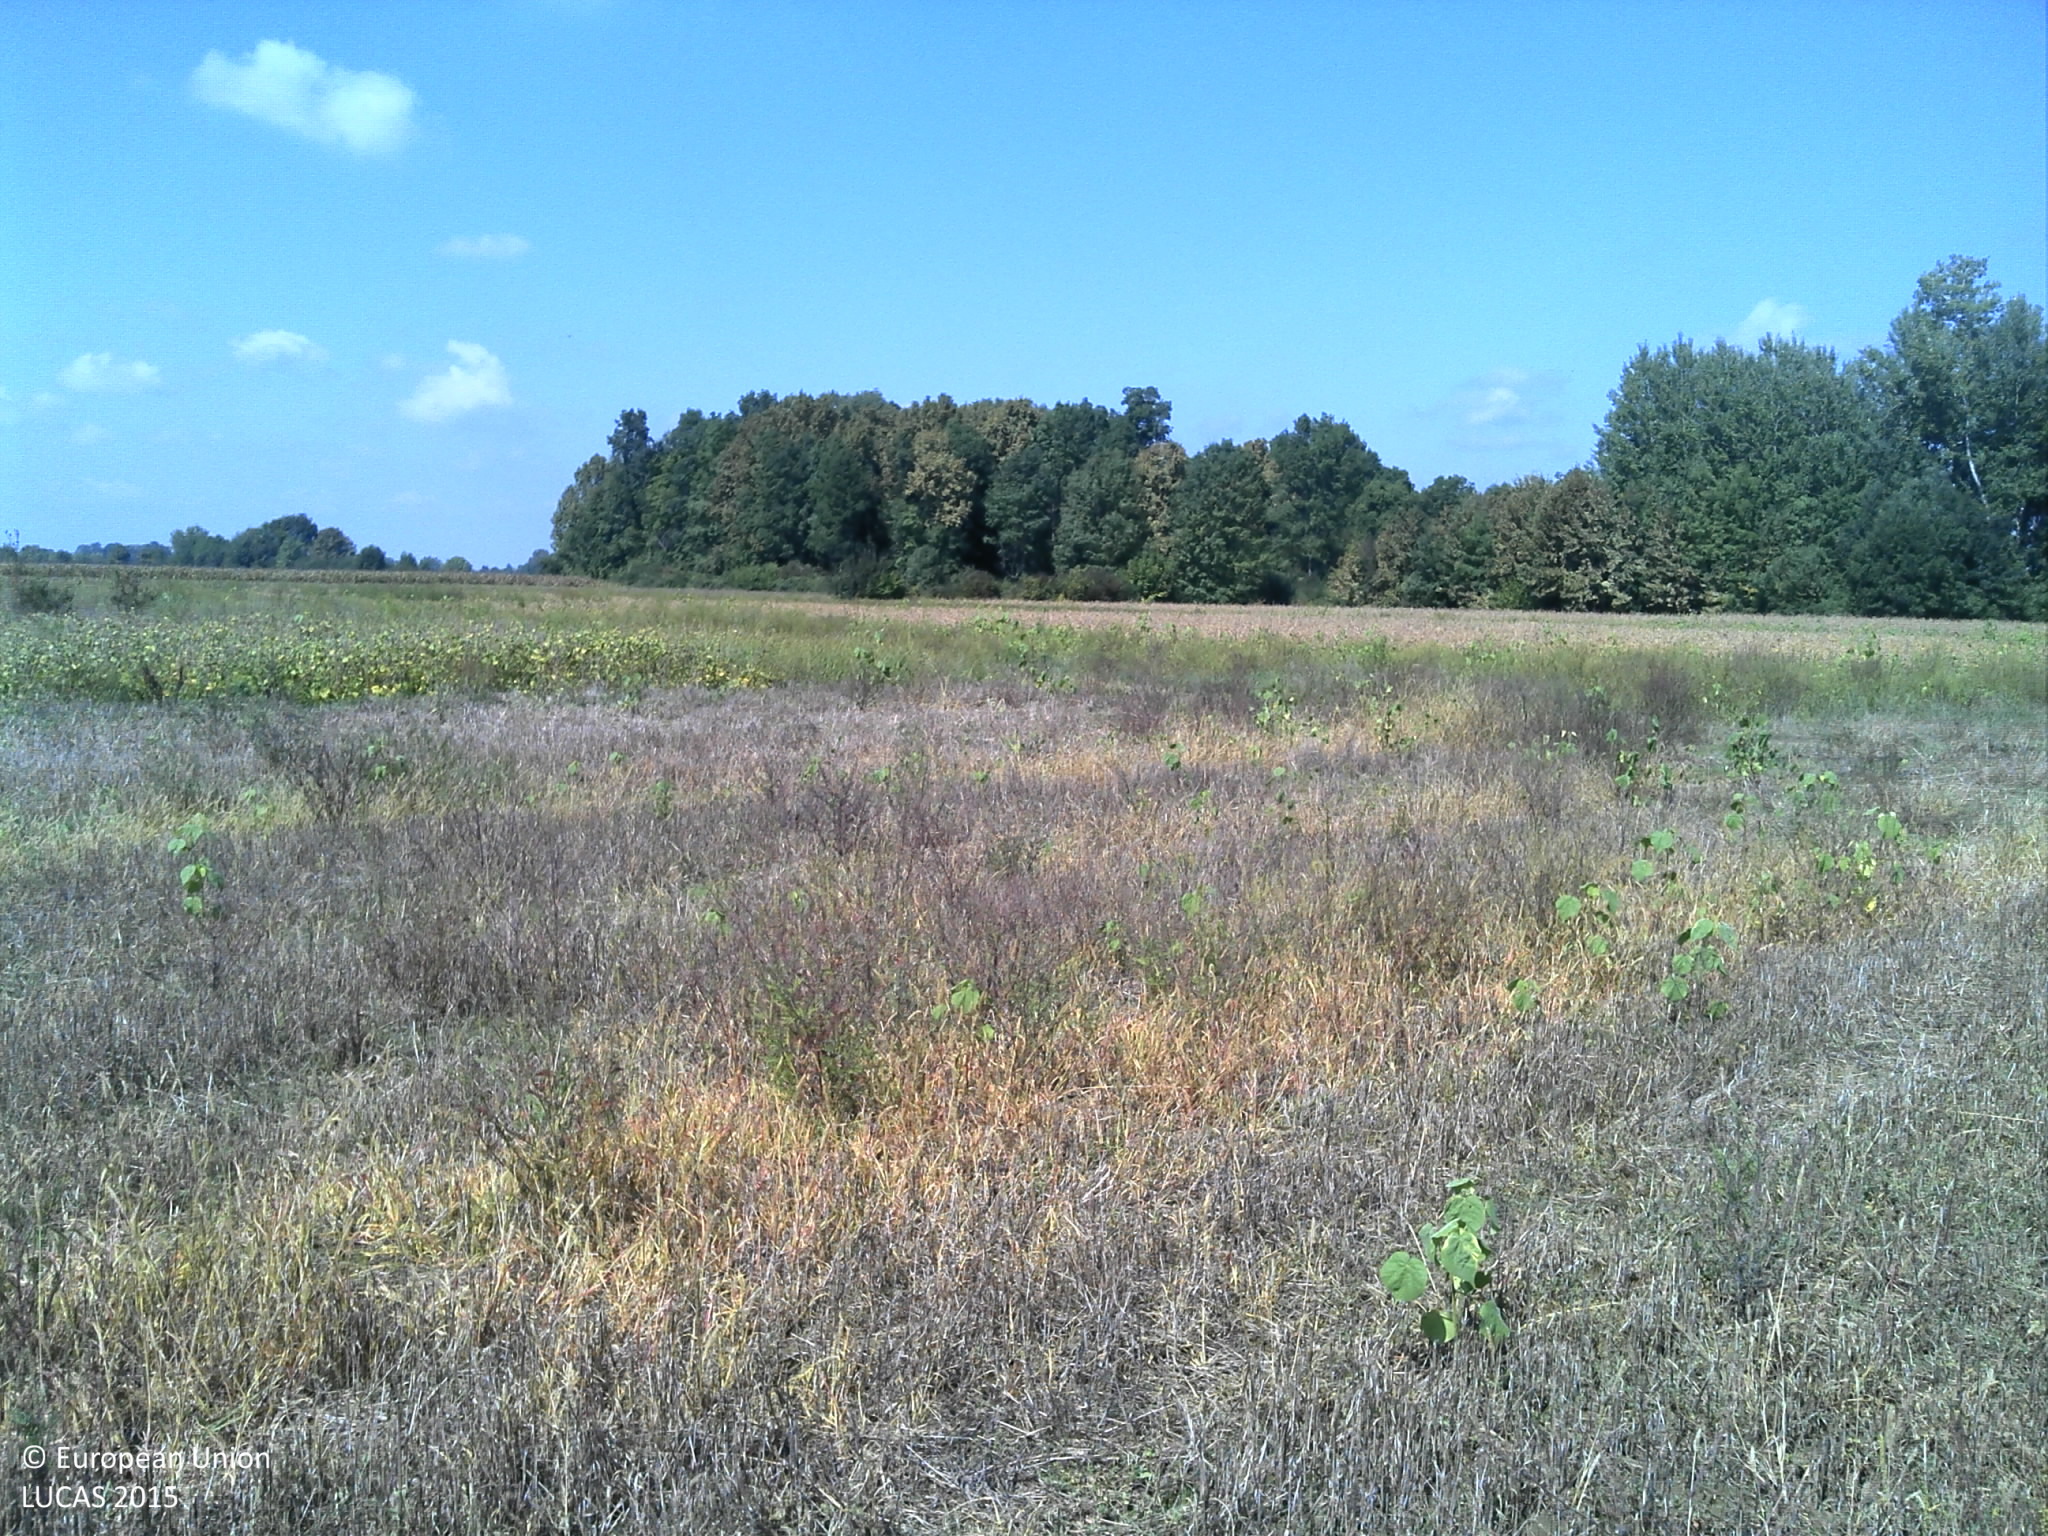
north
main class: Cropland
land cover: Common wheat
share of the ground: > 75 %
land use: Agriculture (excluding fallow land and kitchen gardens)
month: September
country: HR
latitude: 45.1358
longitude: 18.5885
